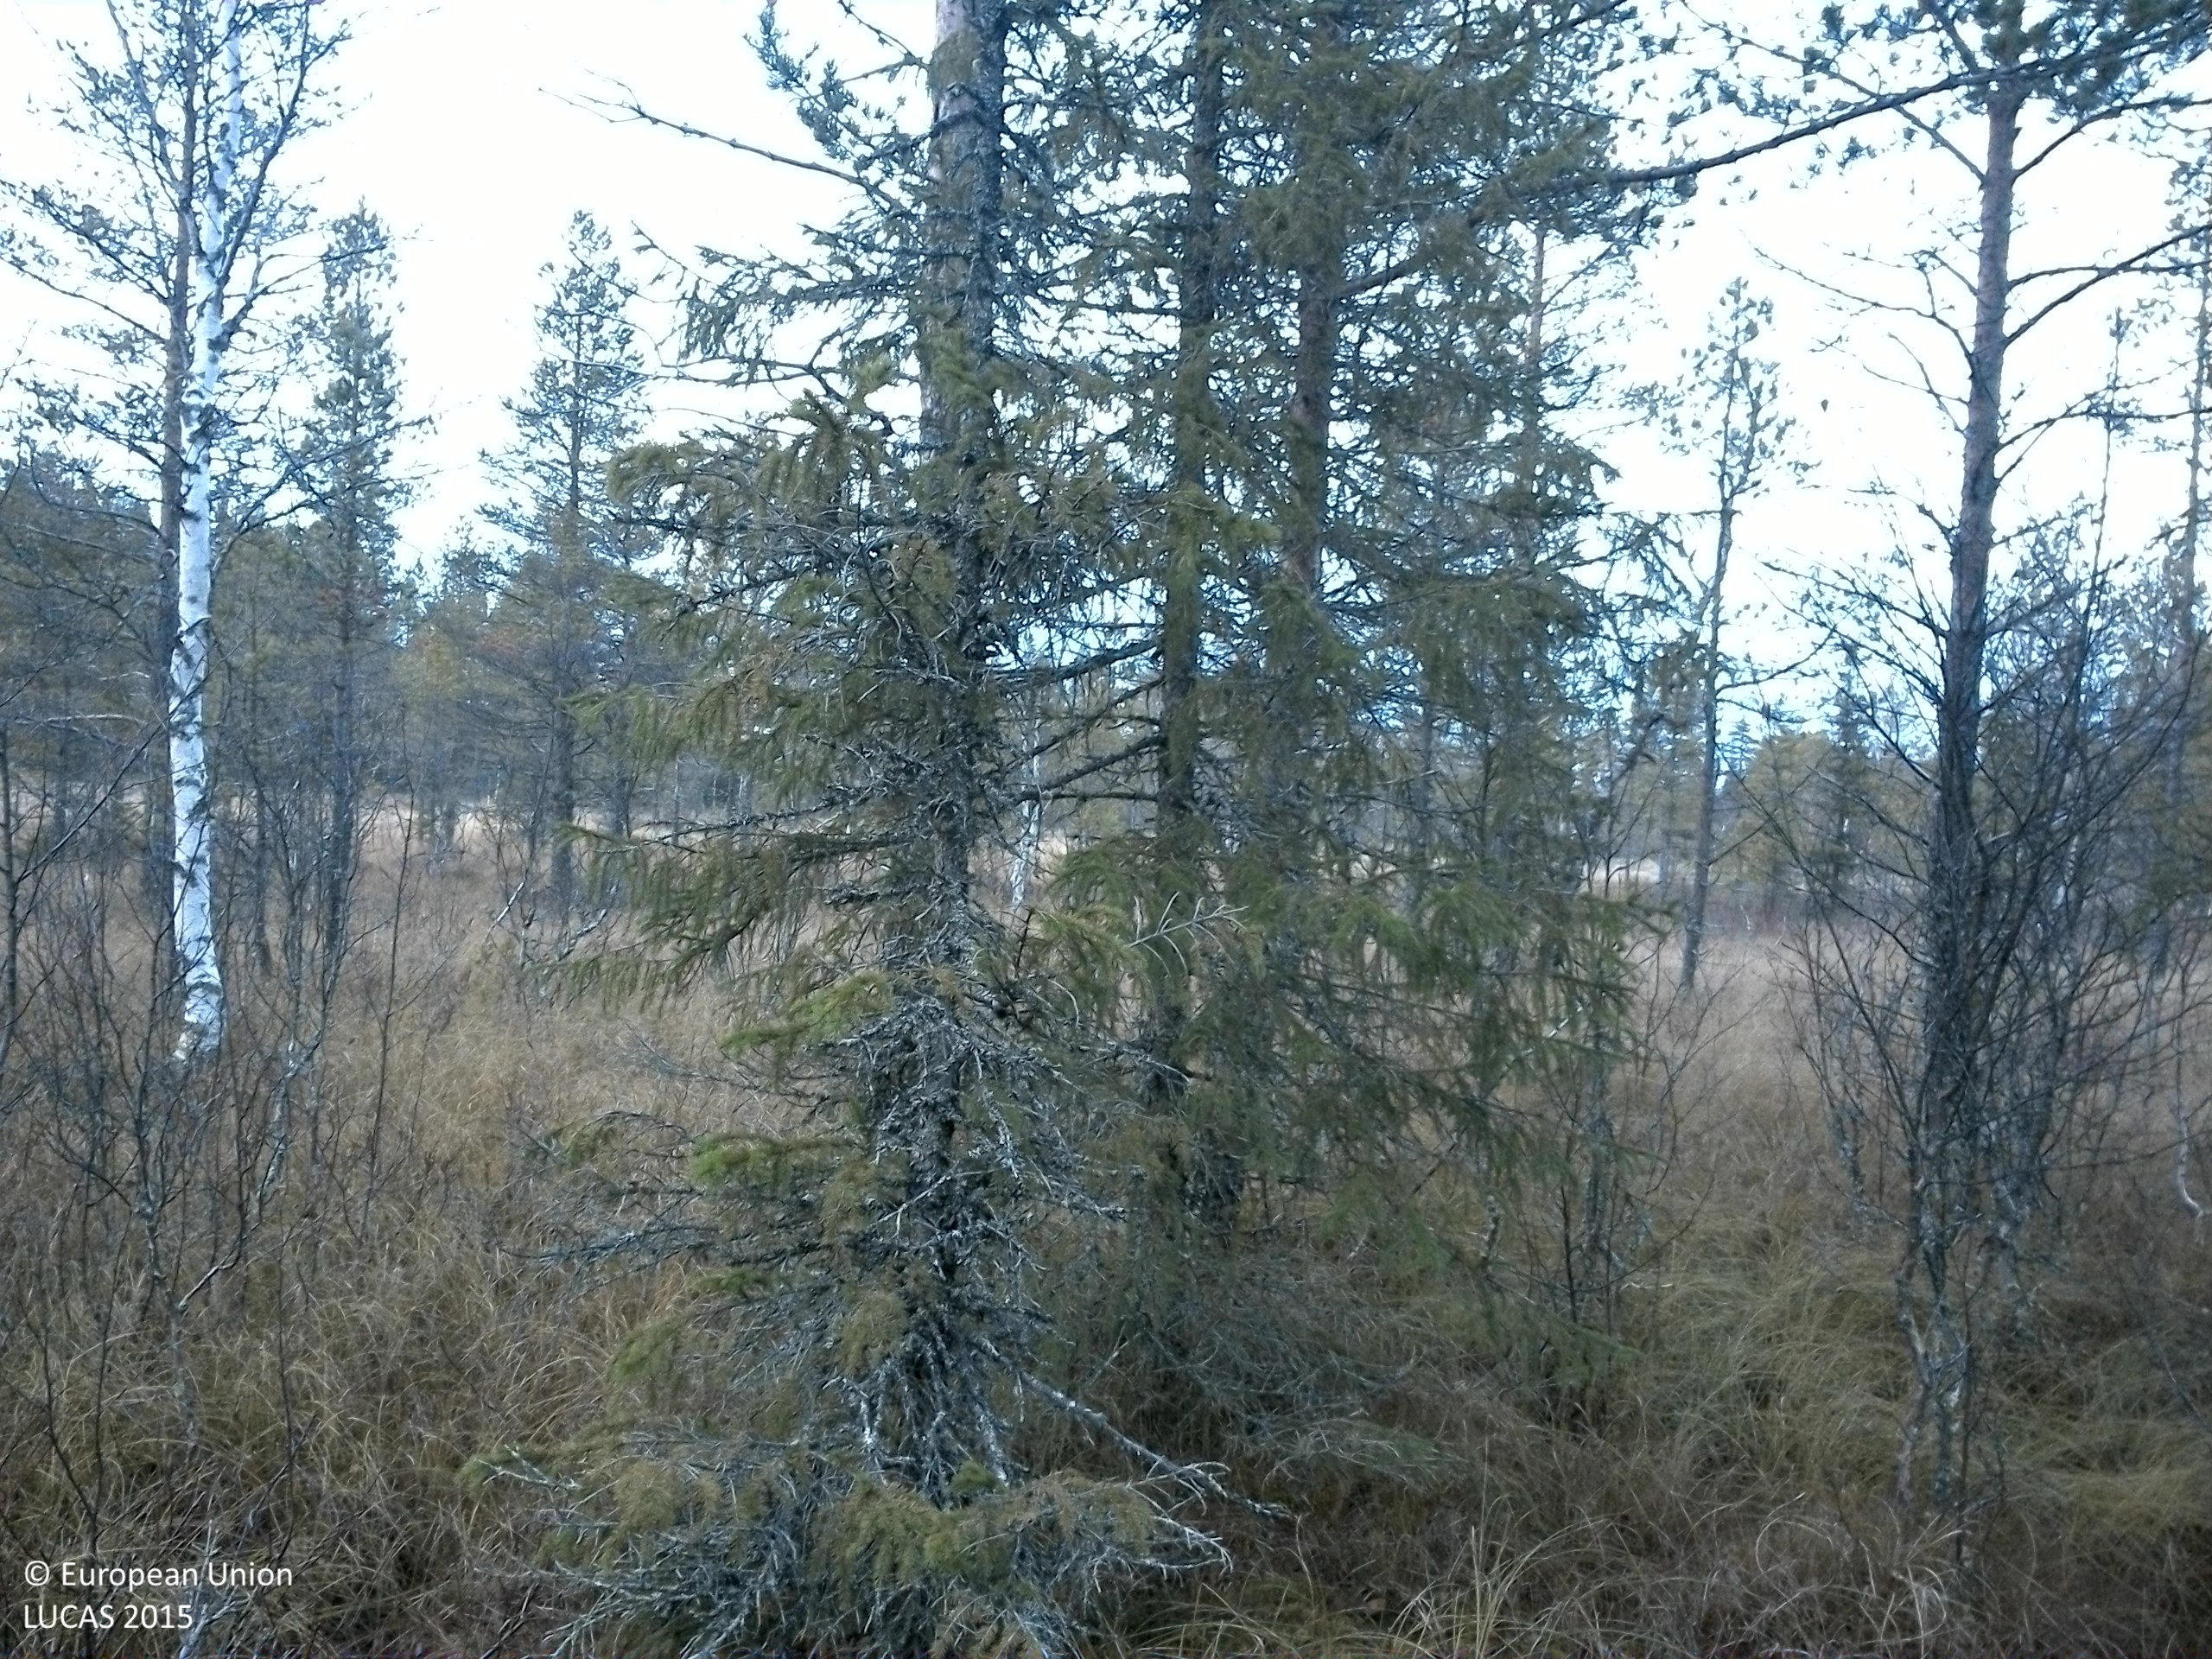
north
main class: Woodland
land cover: Pine dominated mixed woodland
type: mire and swamp forests
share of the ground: 25 - 50 %
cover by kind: coniferous forest trees 25 %, herbaceous plants 25 %, lichens and mosses 25 %, broadleaved forest trees 20 %, shrubs 5 %
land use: Forestry
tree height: > 5 m
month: October
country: SE
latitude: 63.7817
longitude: 15.3909
